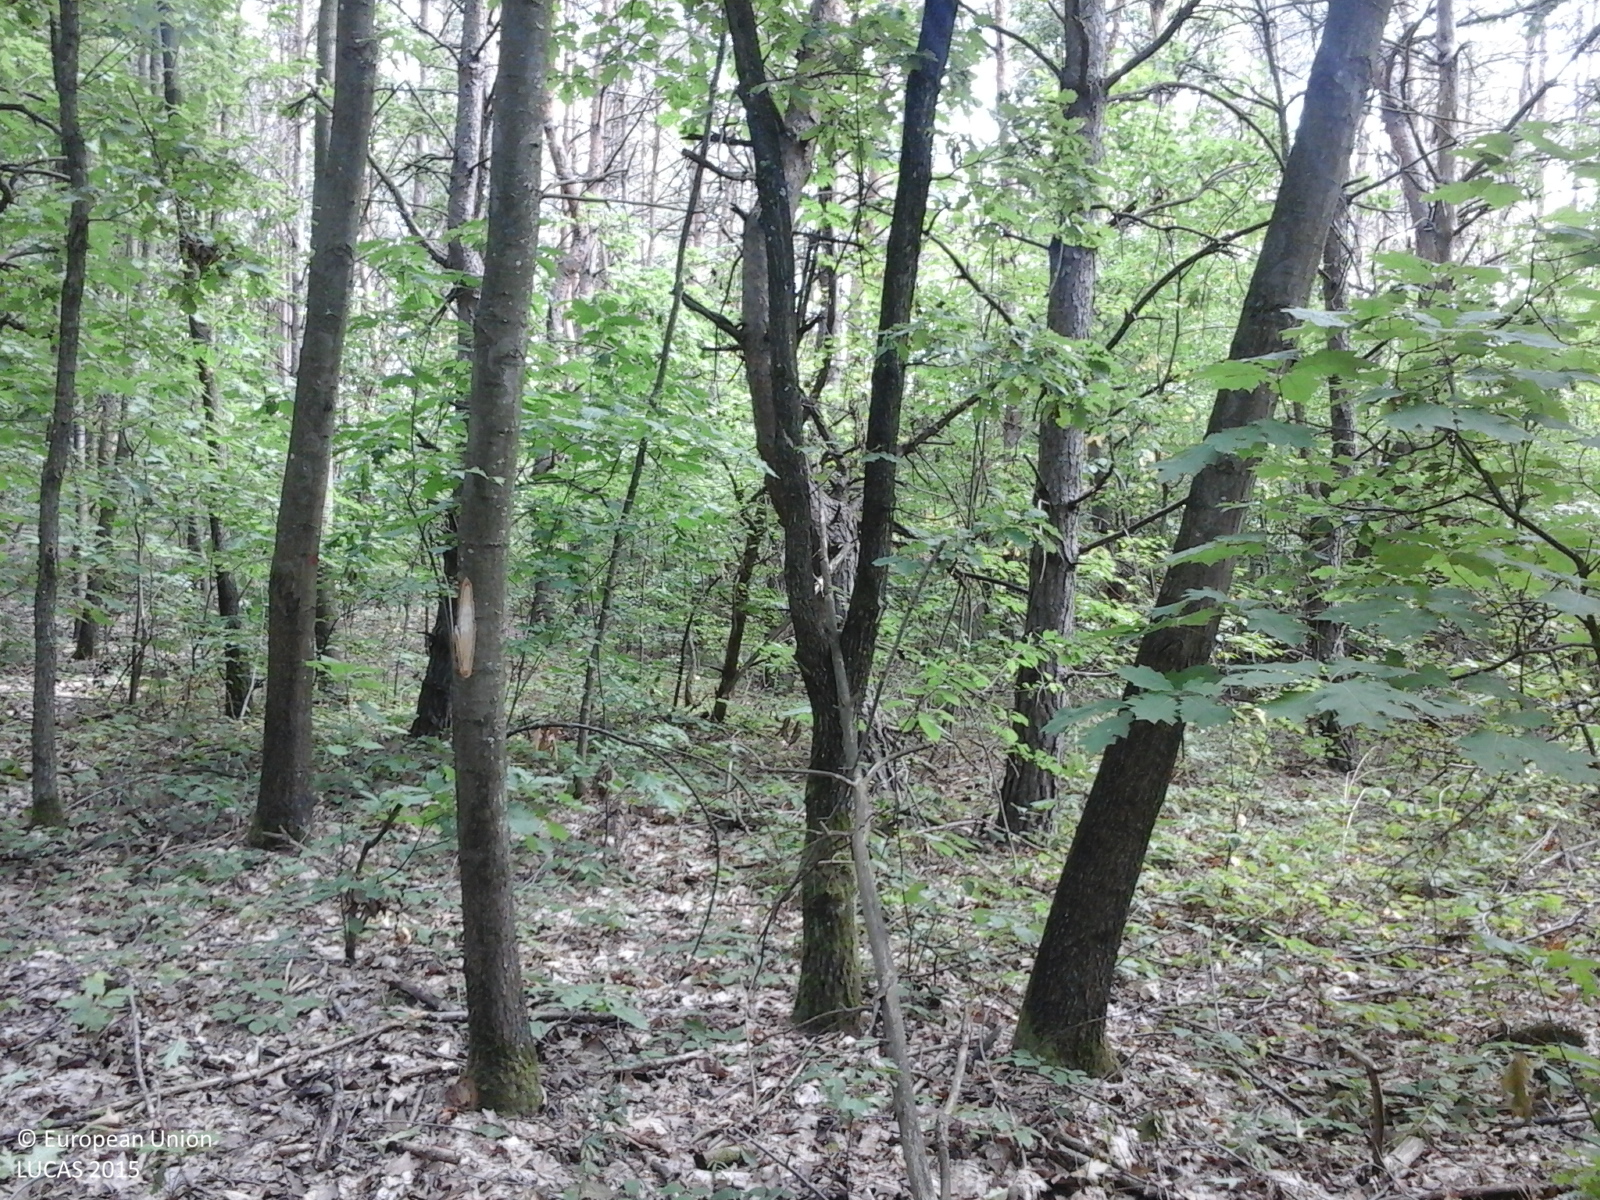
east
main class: Woodland
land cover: Broadleaved woodland
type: mesophytic deciduous forest
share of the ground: > 75 %
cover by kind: broadleaved forest trees 100 %
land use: Forestry
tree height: > 5 m
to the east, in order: Broadleaved woodland; Tracks; Broadleaved woodland
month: September
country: RO
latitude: 47.5598
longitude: 23.2943
